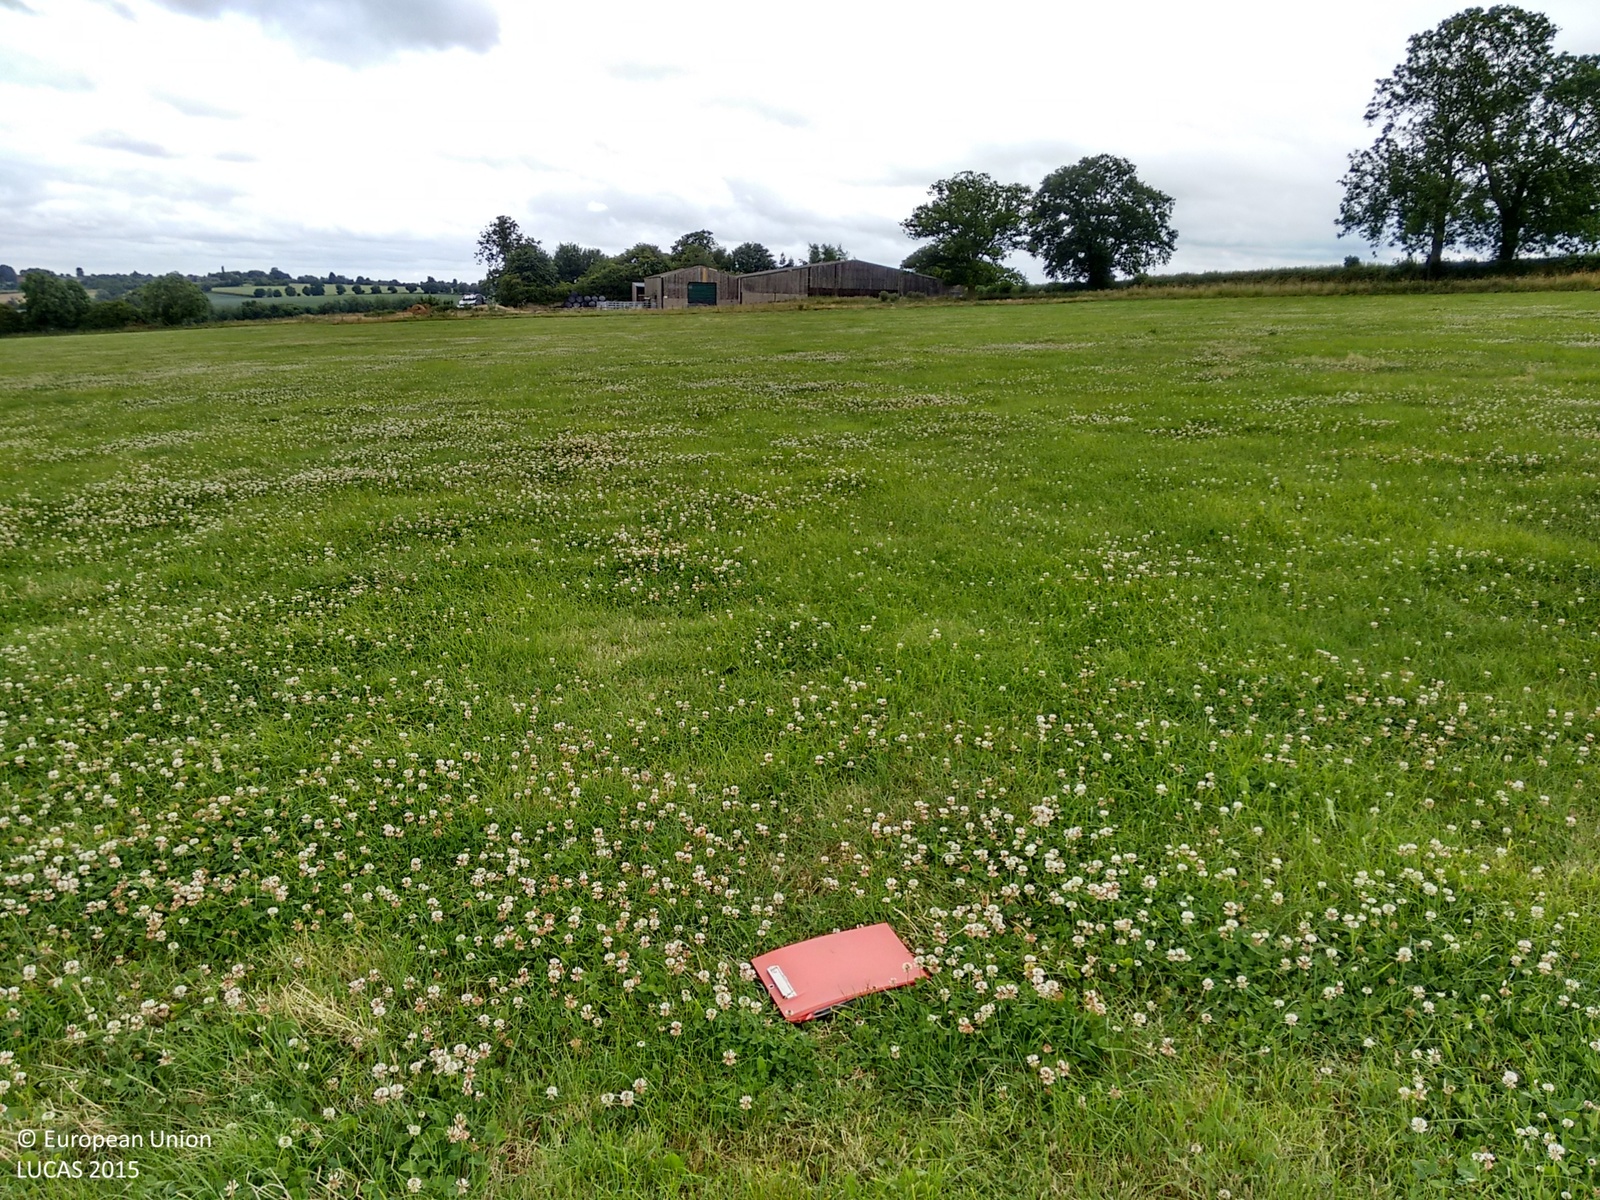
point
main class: Grassland
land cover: Grassland without tree/shrub cover
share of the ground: > 75 %
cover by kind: herbaceous plants 100 %
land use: Agriculture (excluding fallow land and kitchen gardens)
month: July
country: GB
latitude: 52.1227
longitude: -1.3392
